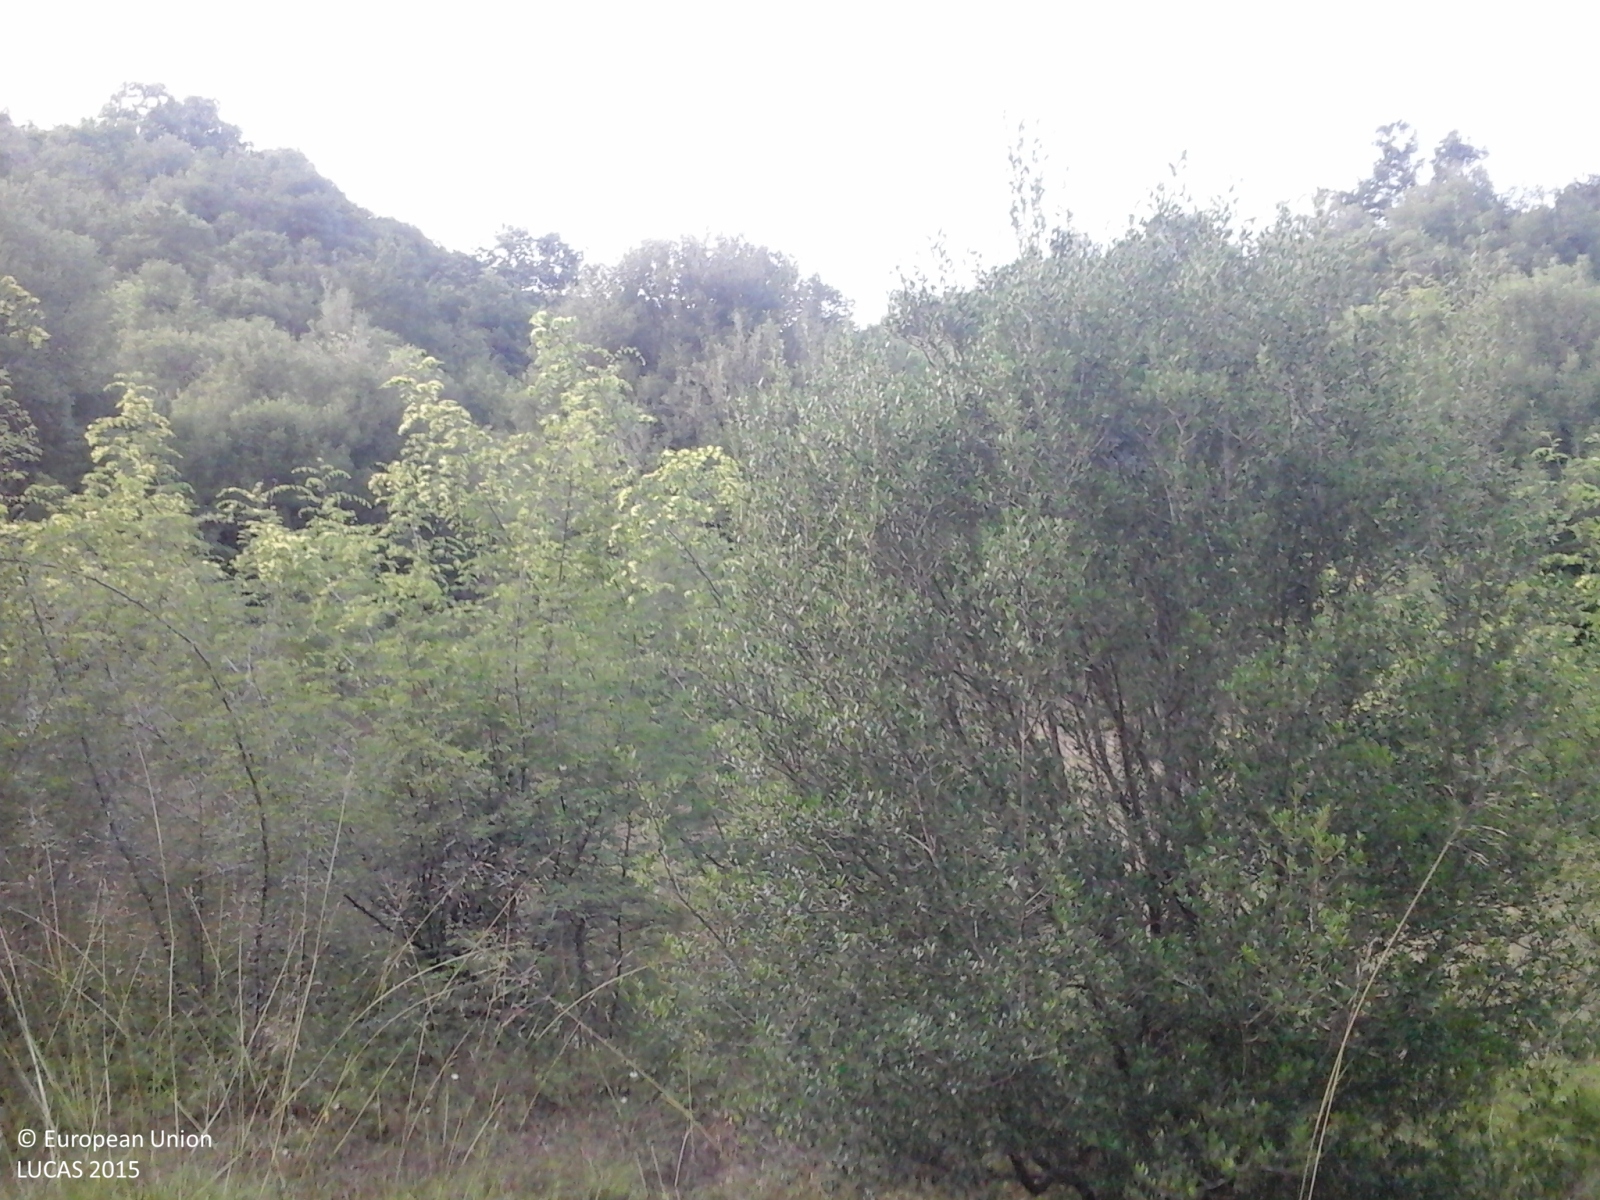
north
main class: Woodland
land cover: Broadleaved woodland
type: thermophilous deciduous forest
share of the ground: > 75 %
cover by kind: broadleaved forest trees 80 %, herbaceous plants 15 %, shrubs 5 %
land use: Forestry
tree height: > 5 m
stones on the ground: < 10 %
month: July
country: GR
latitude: 39.4024
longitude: 20.7401
